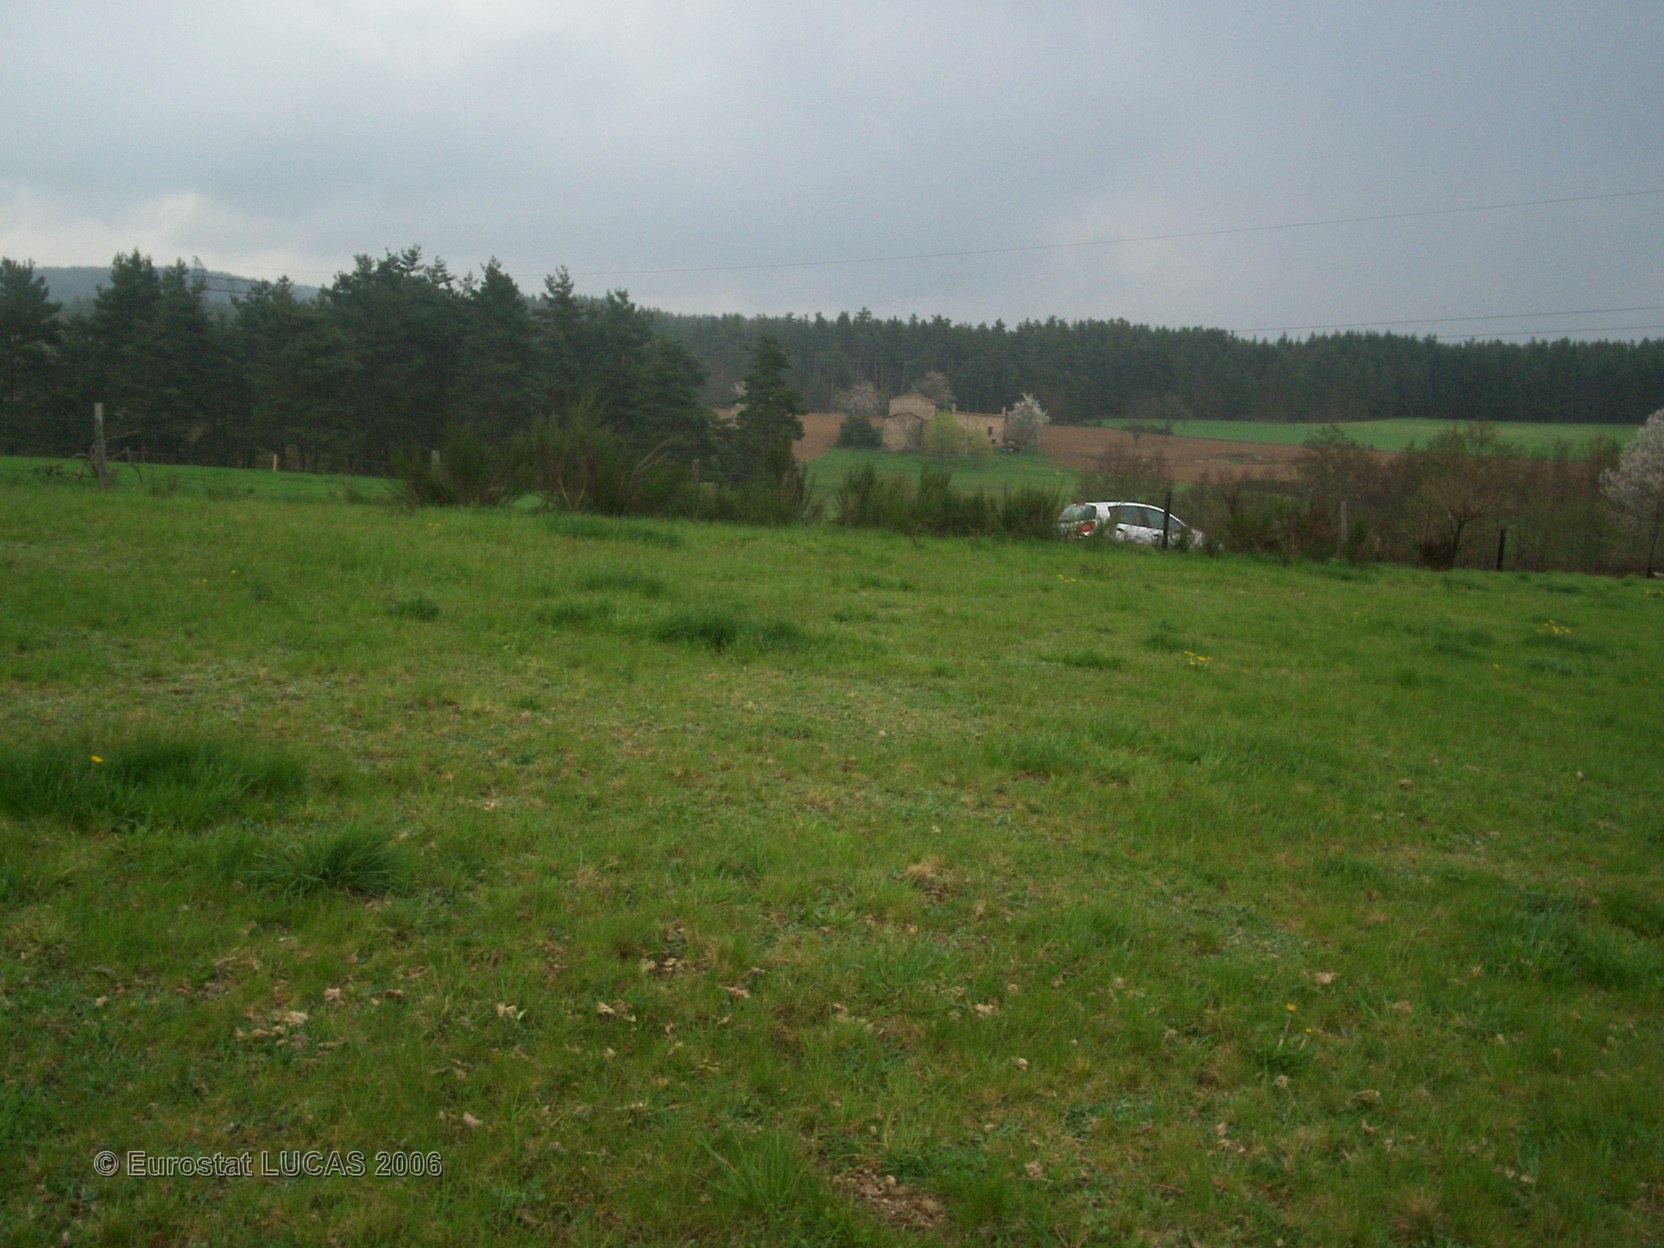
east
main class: Grassland
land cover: Grassland without tree/shrub cover
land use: Agriculture (excluding fallow land and kitchen gardens)
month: April
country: FR
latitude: 45.2536
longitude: 4.1808
